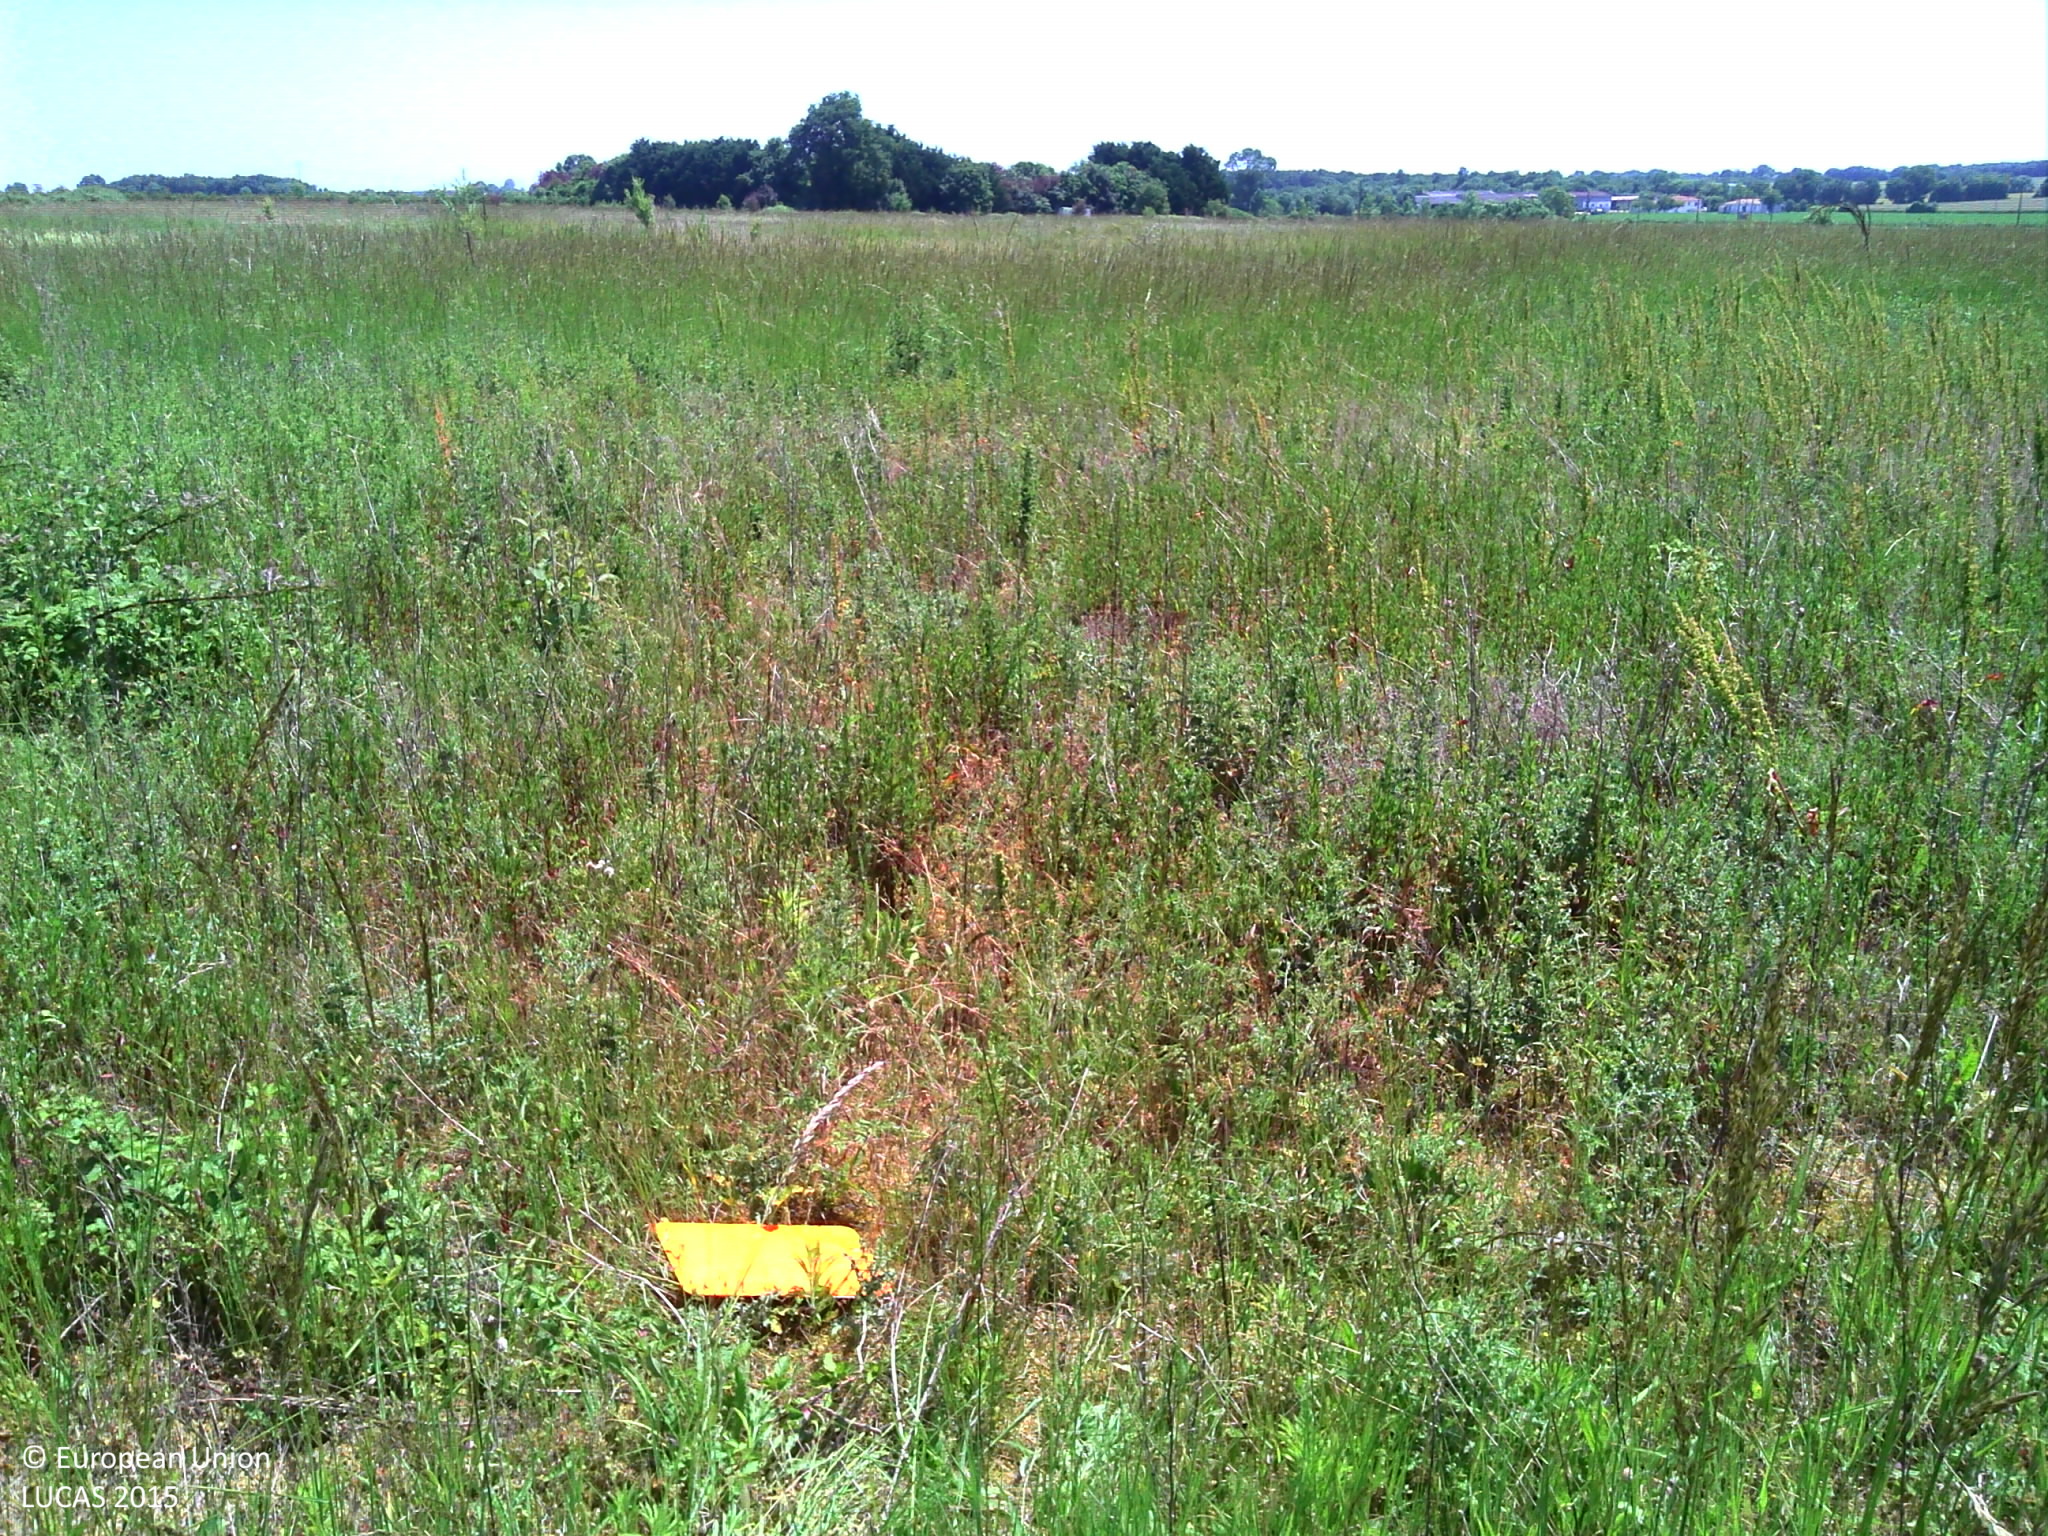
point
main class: Grassland
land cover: Grassland without tree/shrub cover
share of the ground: > 75 %
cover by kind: herbaceous plants 95 %, shrubs 5 %
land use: Agriculture (excluding fallow land and kitchen gardens)
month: June
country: FR
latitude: 46.1518
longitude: -0.7613
